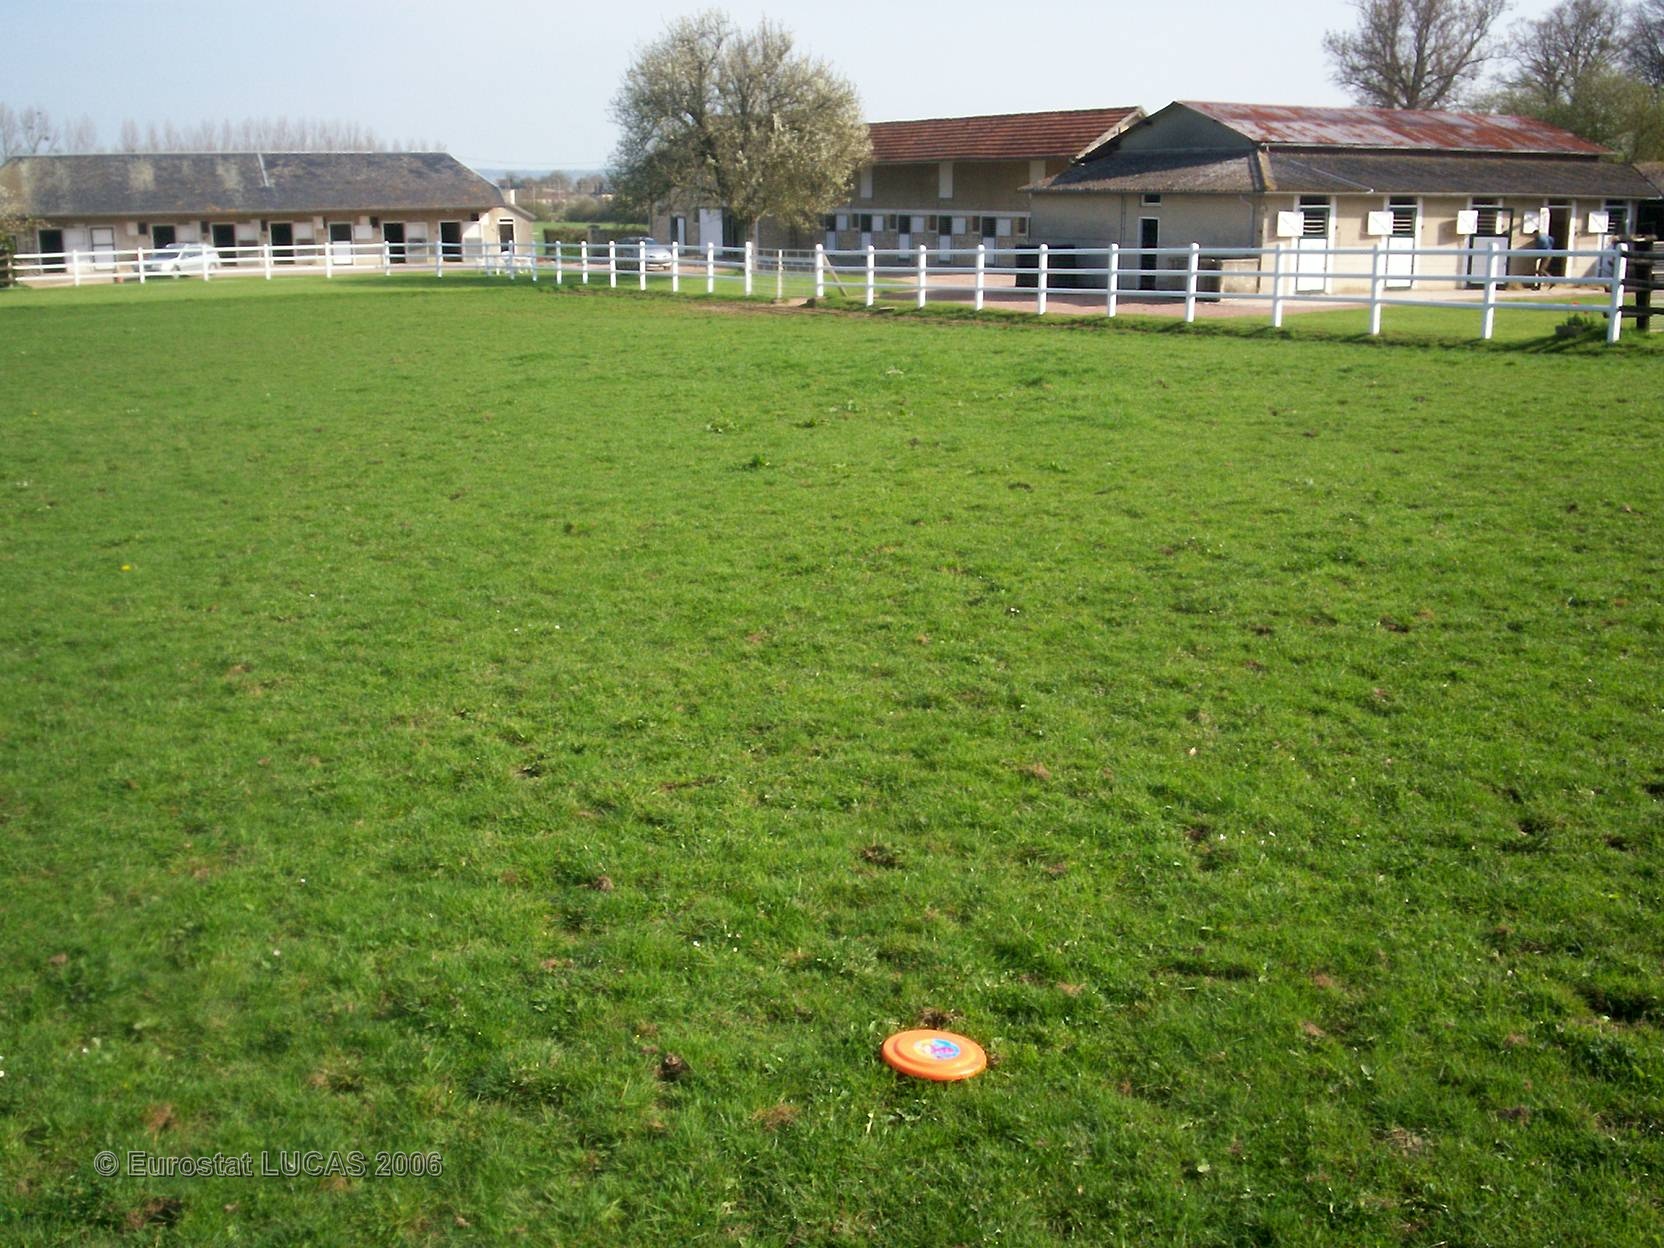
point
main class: Grassland
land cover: Grassland without tree/shrub cover
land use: Agriculture (excluding fallow land and kitchen gardens)
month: April
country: FR
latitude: 49.0720
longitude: -0.0100
